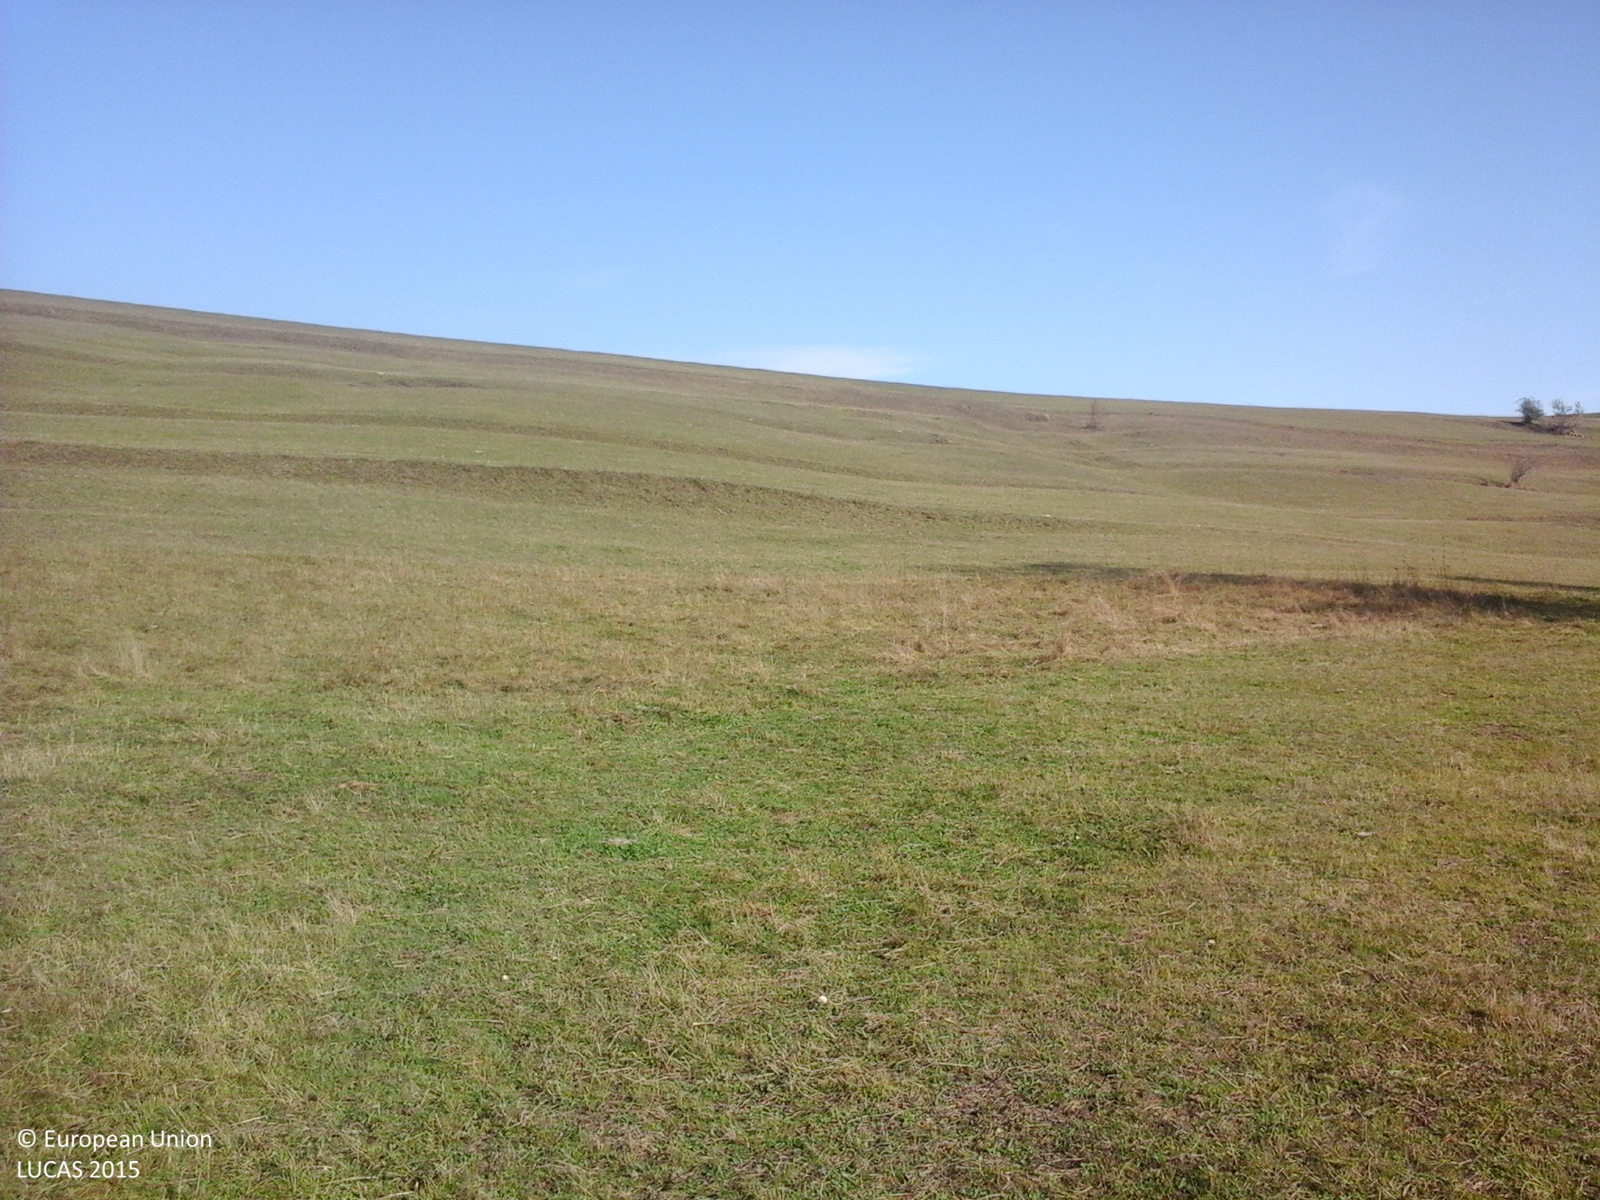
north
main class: Grassland
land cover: Grassland without tree/shrub cover
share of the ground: > 75 %
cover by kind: herbaceous plants 100 %
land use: Agriculture (excluding fallow land and kitchen gardens)
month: October
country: RO
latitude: 46.0637
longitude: 26.0584
